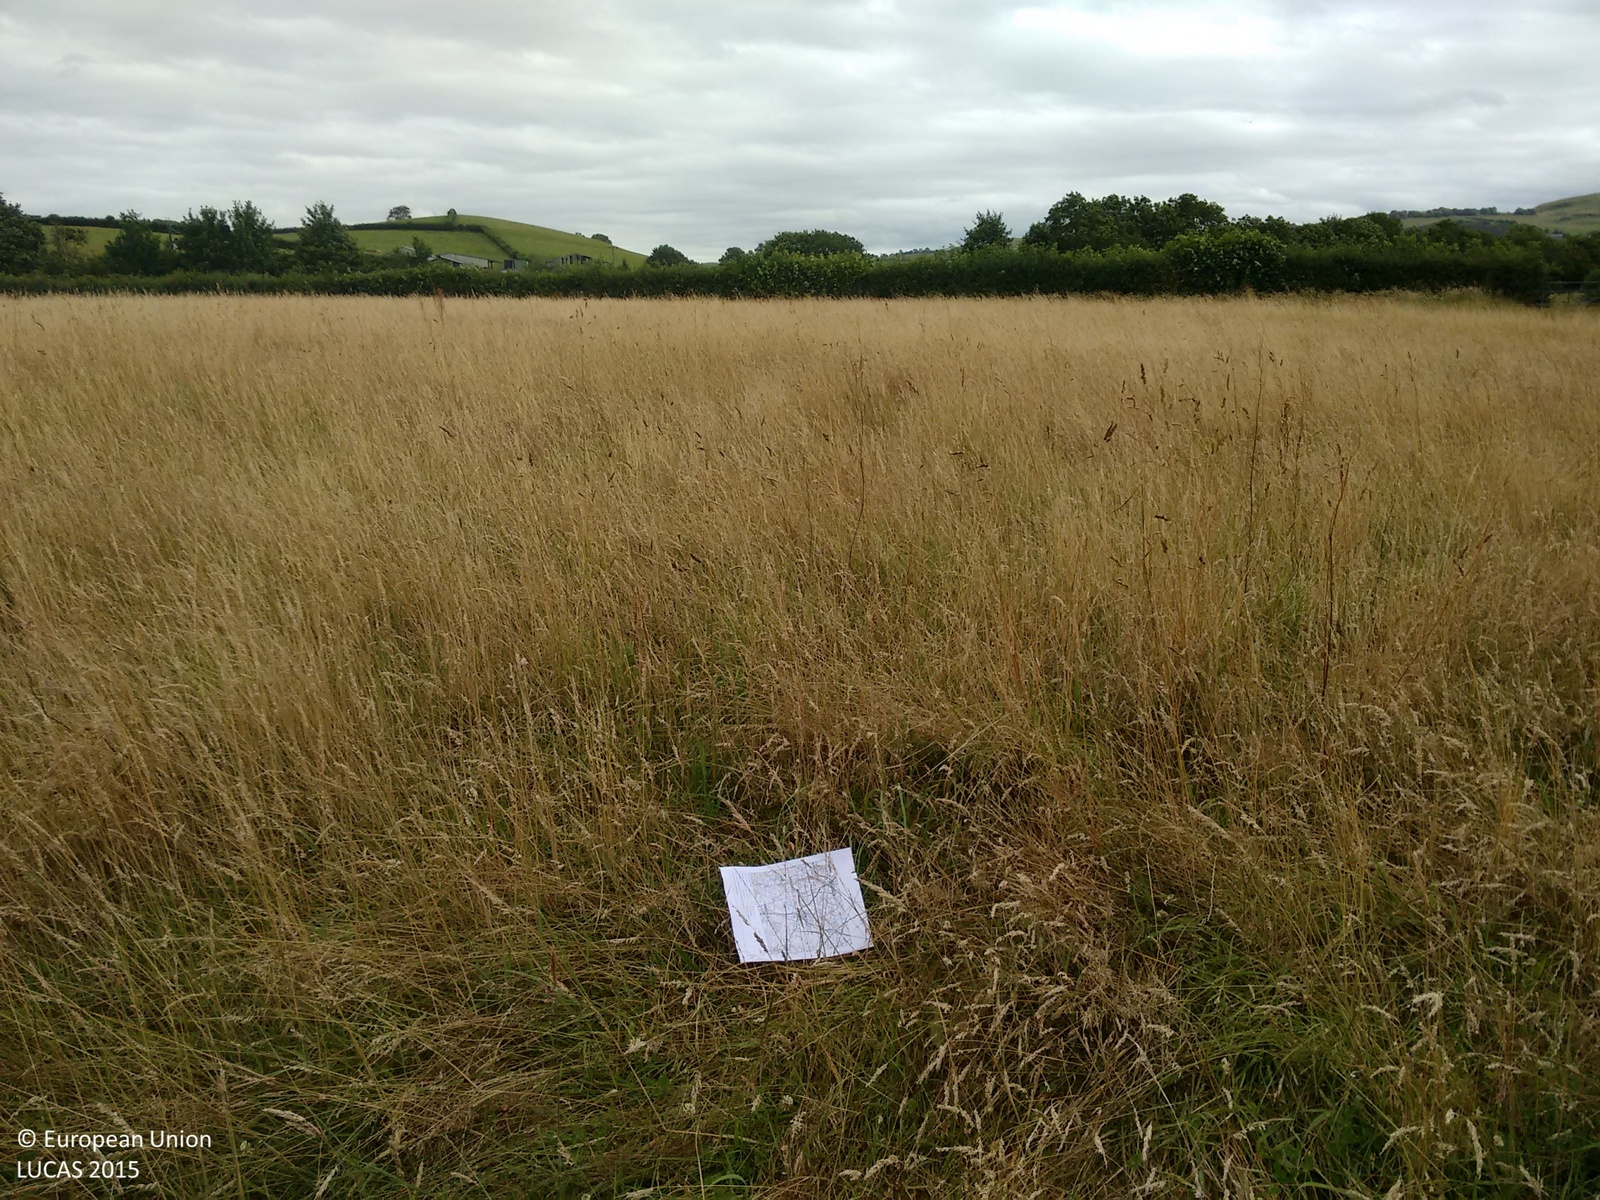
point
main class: Grassland
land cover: Grassland without tree/shrub cover
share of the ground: > 75 %
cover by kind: herbaceous plants 100 %
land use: Agriculture (excluding fallow land and kitchen gardens)
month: August
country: GB
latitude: 54.2388
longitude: -2.7267
